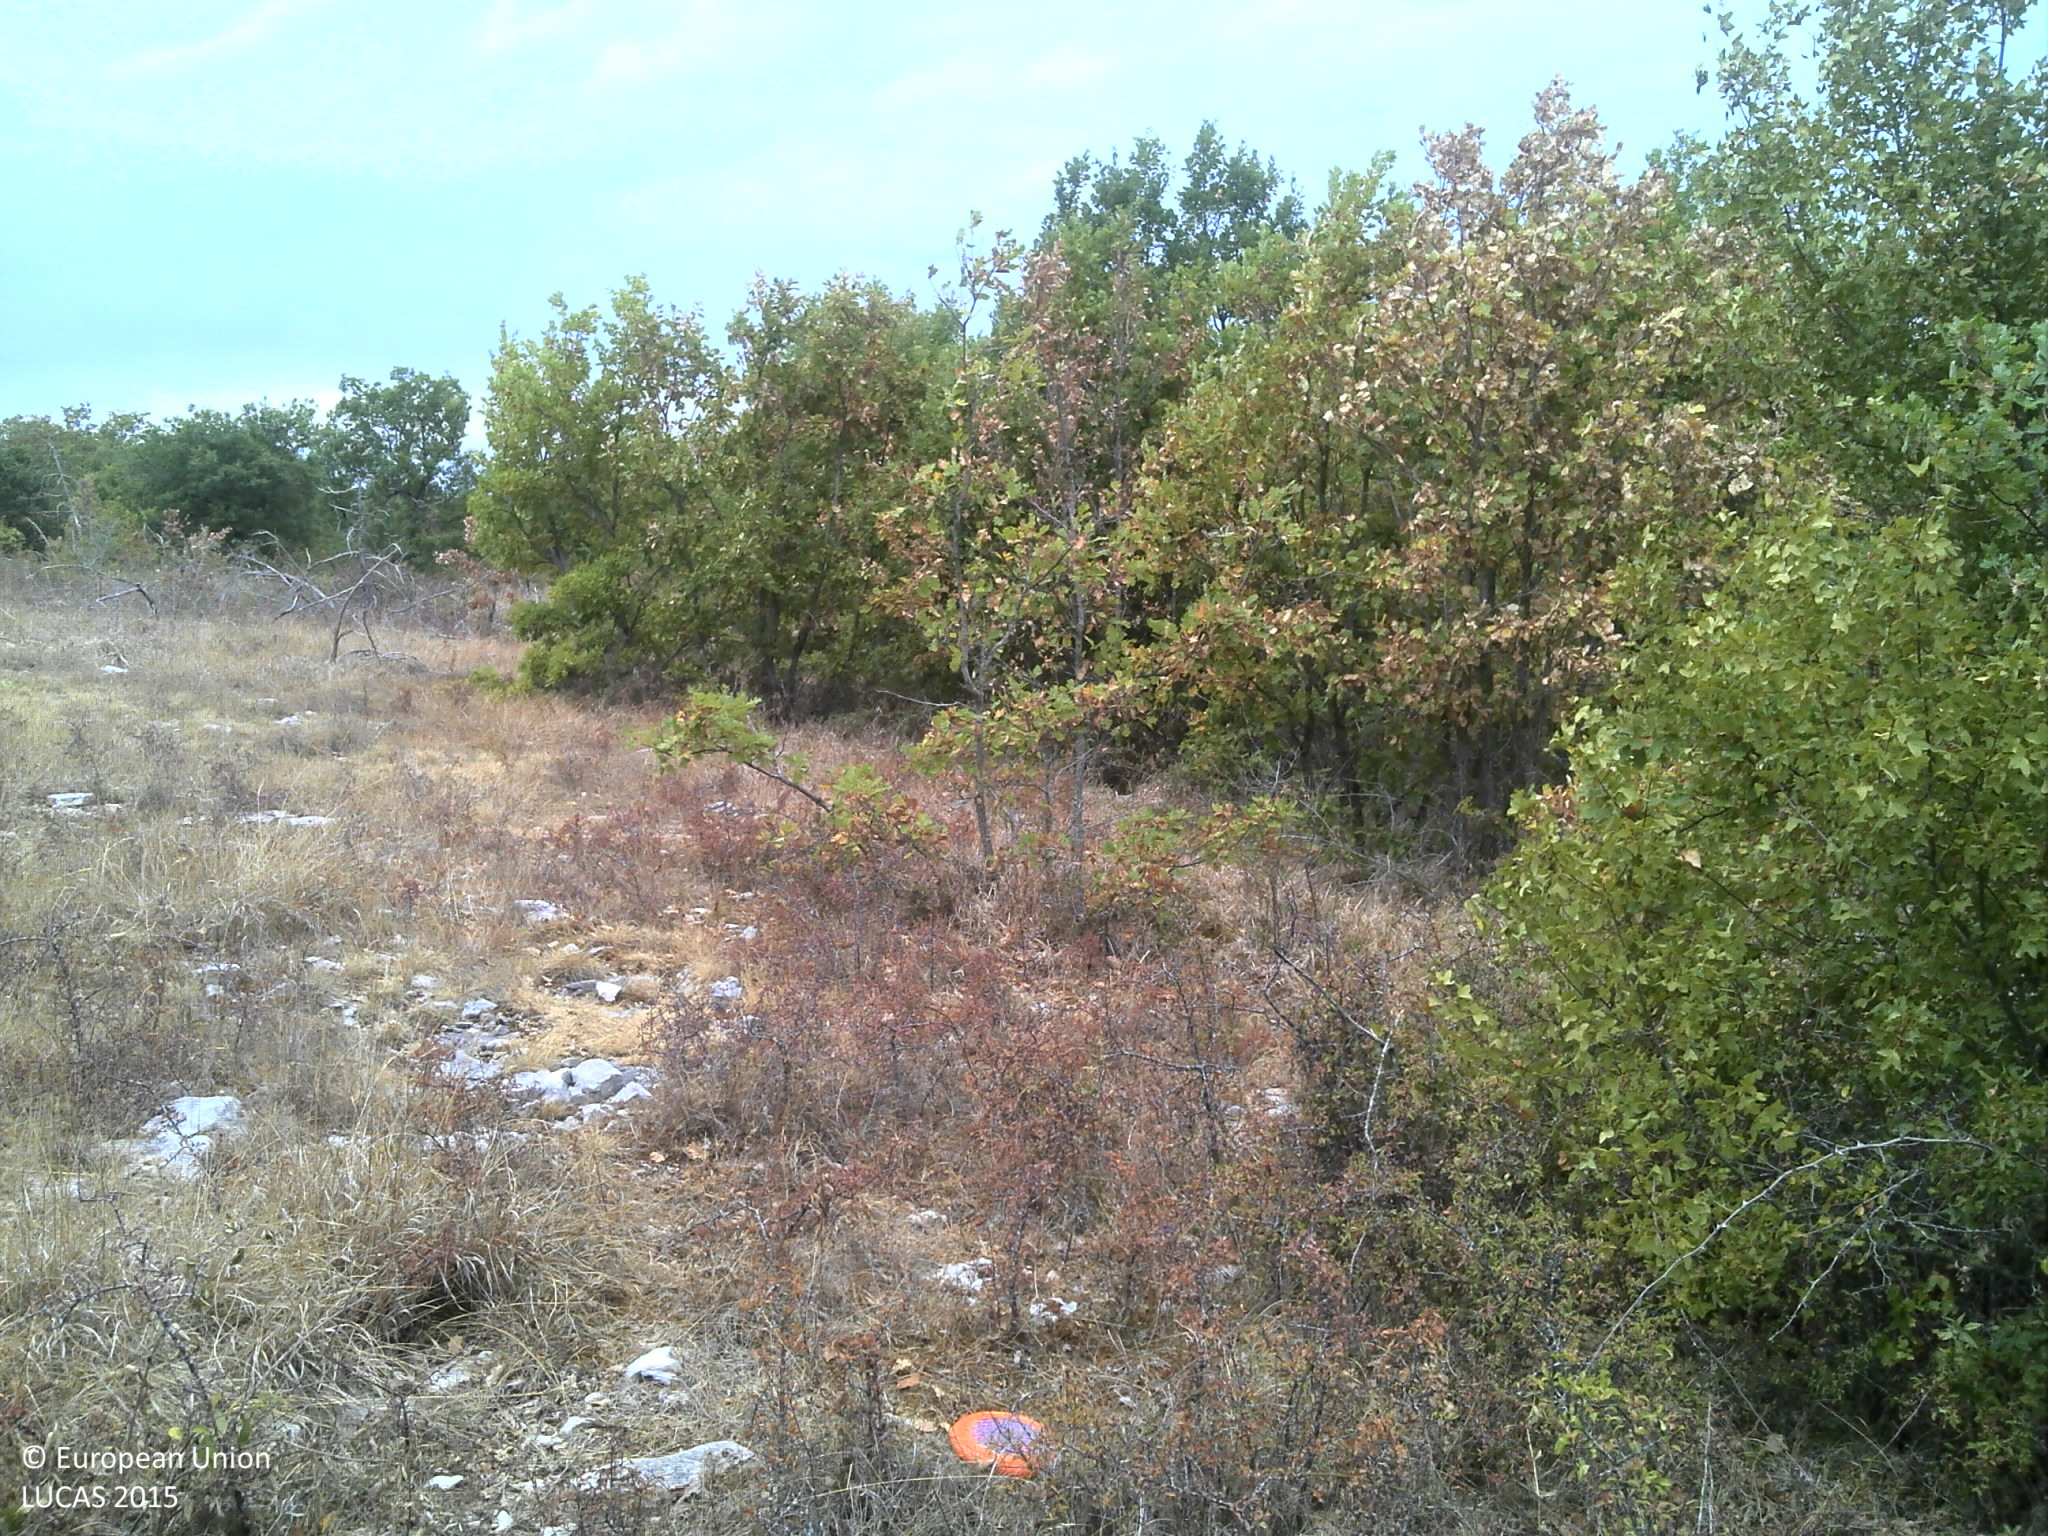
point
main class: Shrubland
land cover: Shrubland with sparse tree cover
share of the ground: > 75 %
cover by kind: shrubs 50 %, herbaceous plants 40 %, broadleaved forest trees 5 %, lichens and mosses 5 %
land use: Semi-natural and natural areas not in use
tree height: < 5 m
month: July
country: FR
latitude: 45.0821
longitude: 1.4198
